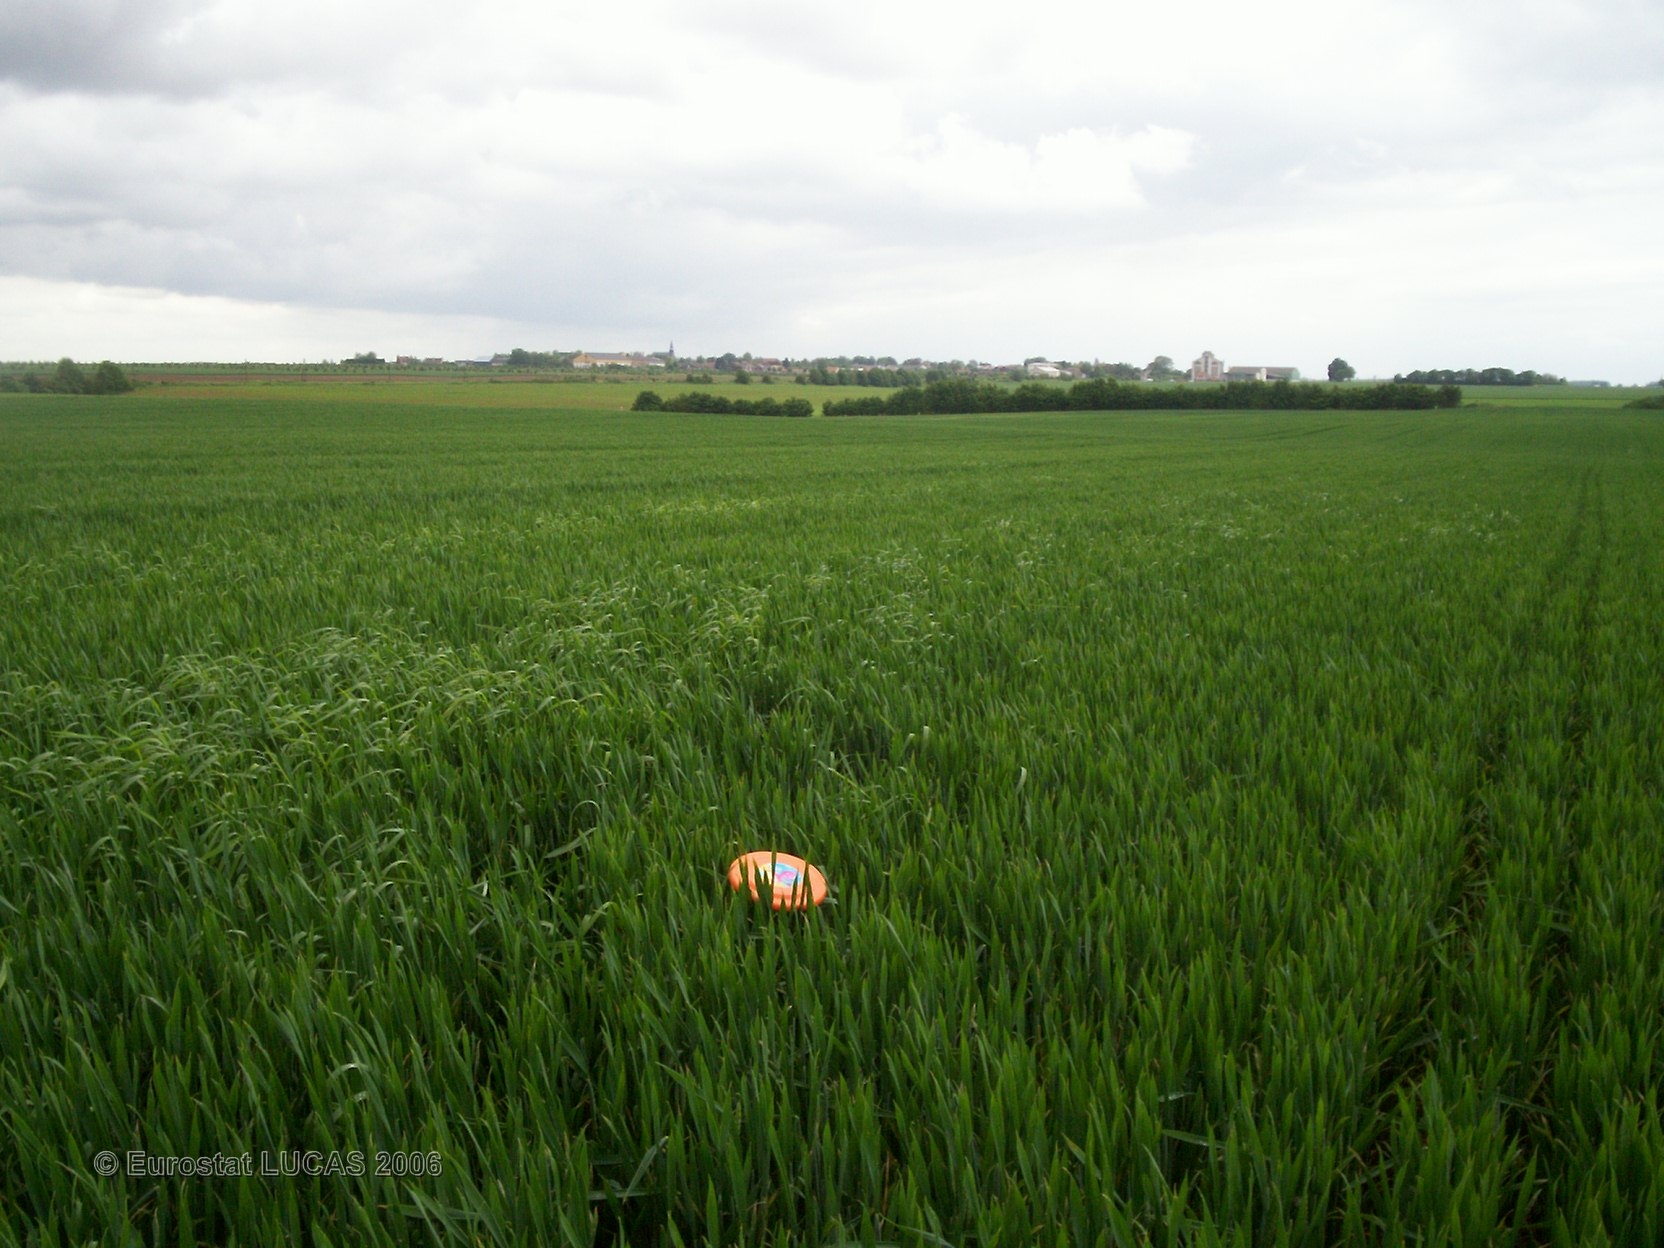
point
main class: Cropland
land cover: Common wheat
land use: Agriculture (excluding fallow land and kitchen gardens)
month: May
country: FR
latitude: 49.8535
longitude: 2.6027
